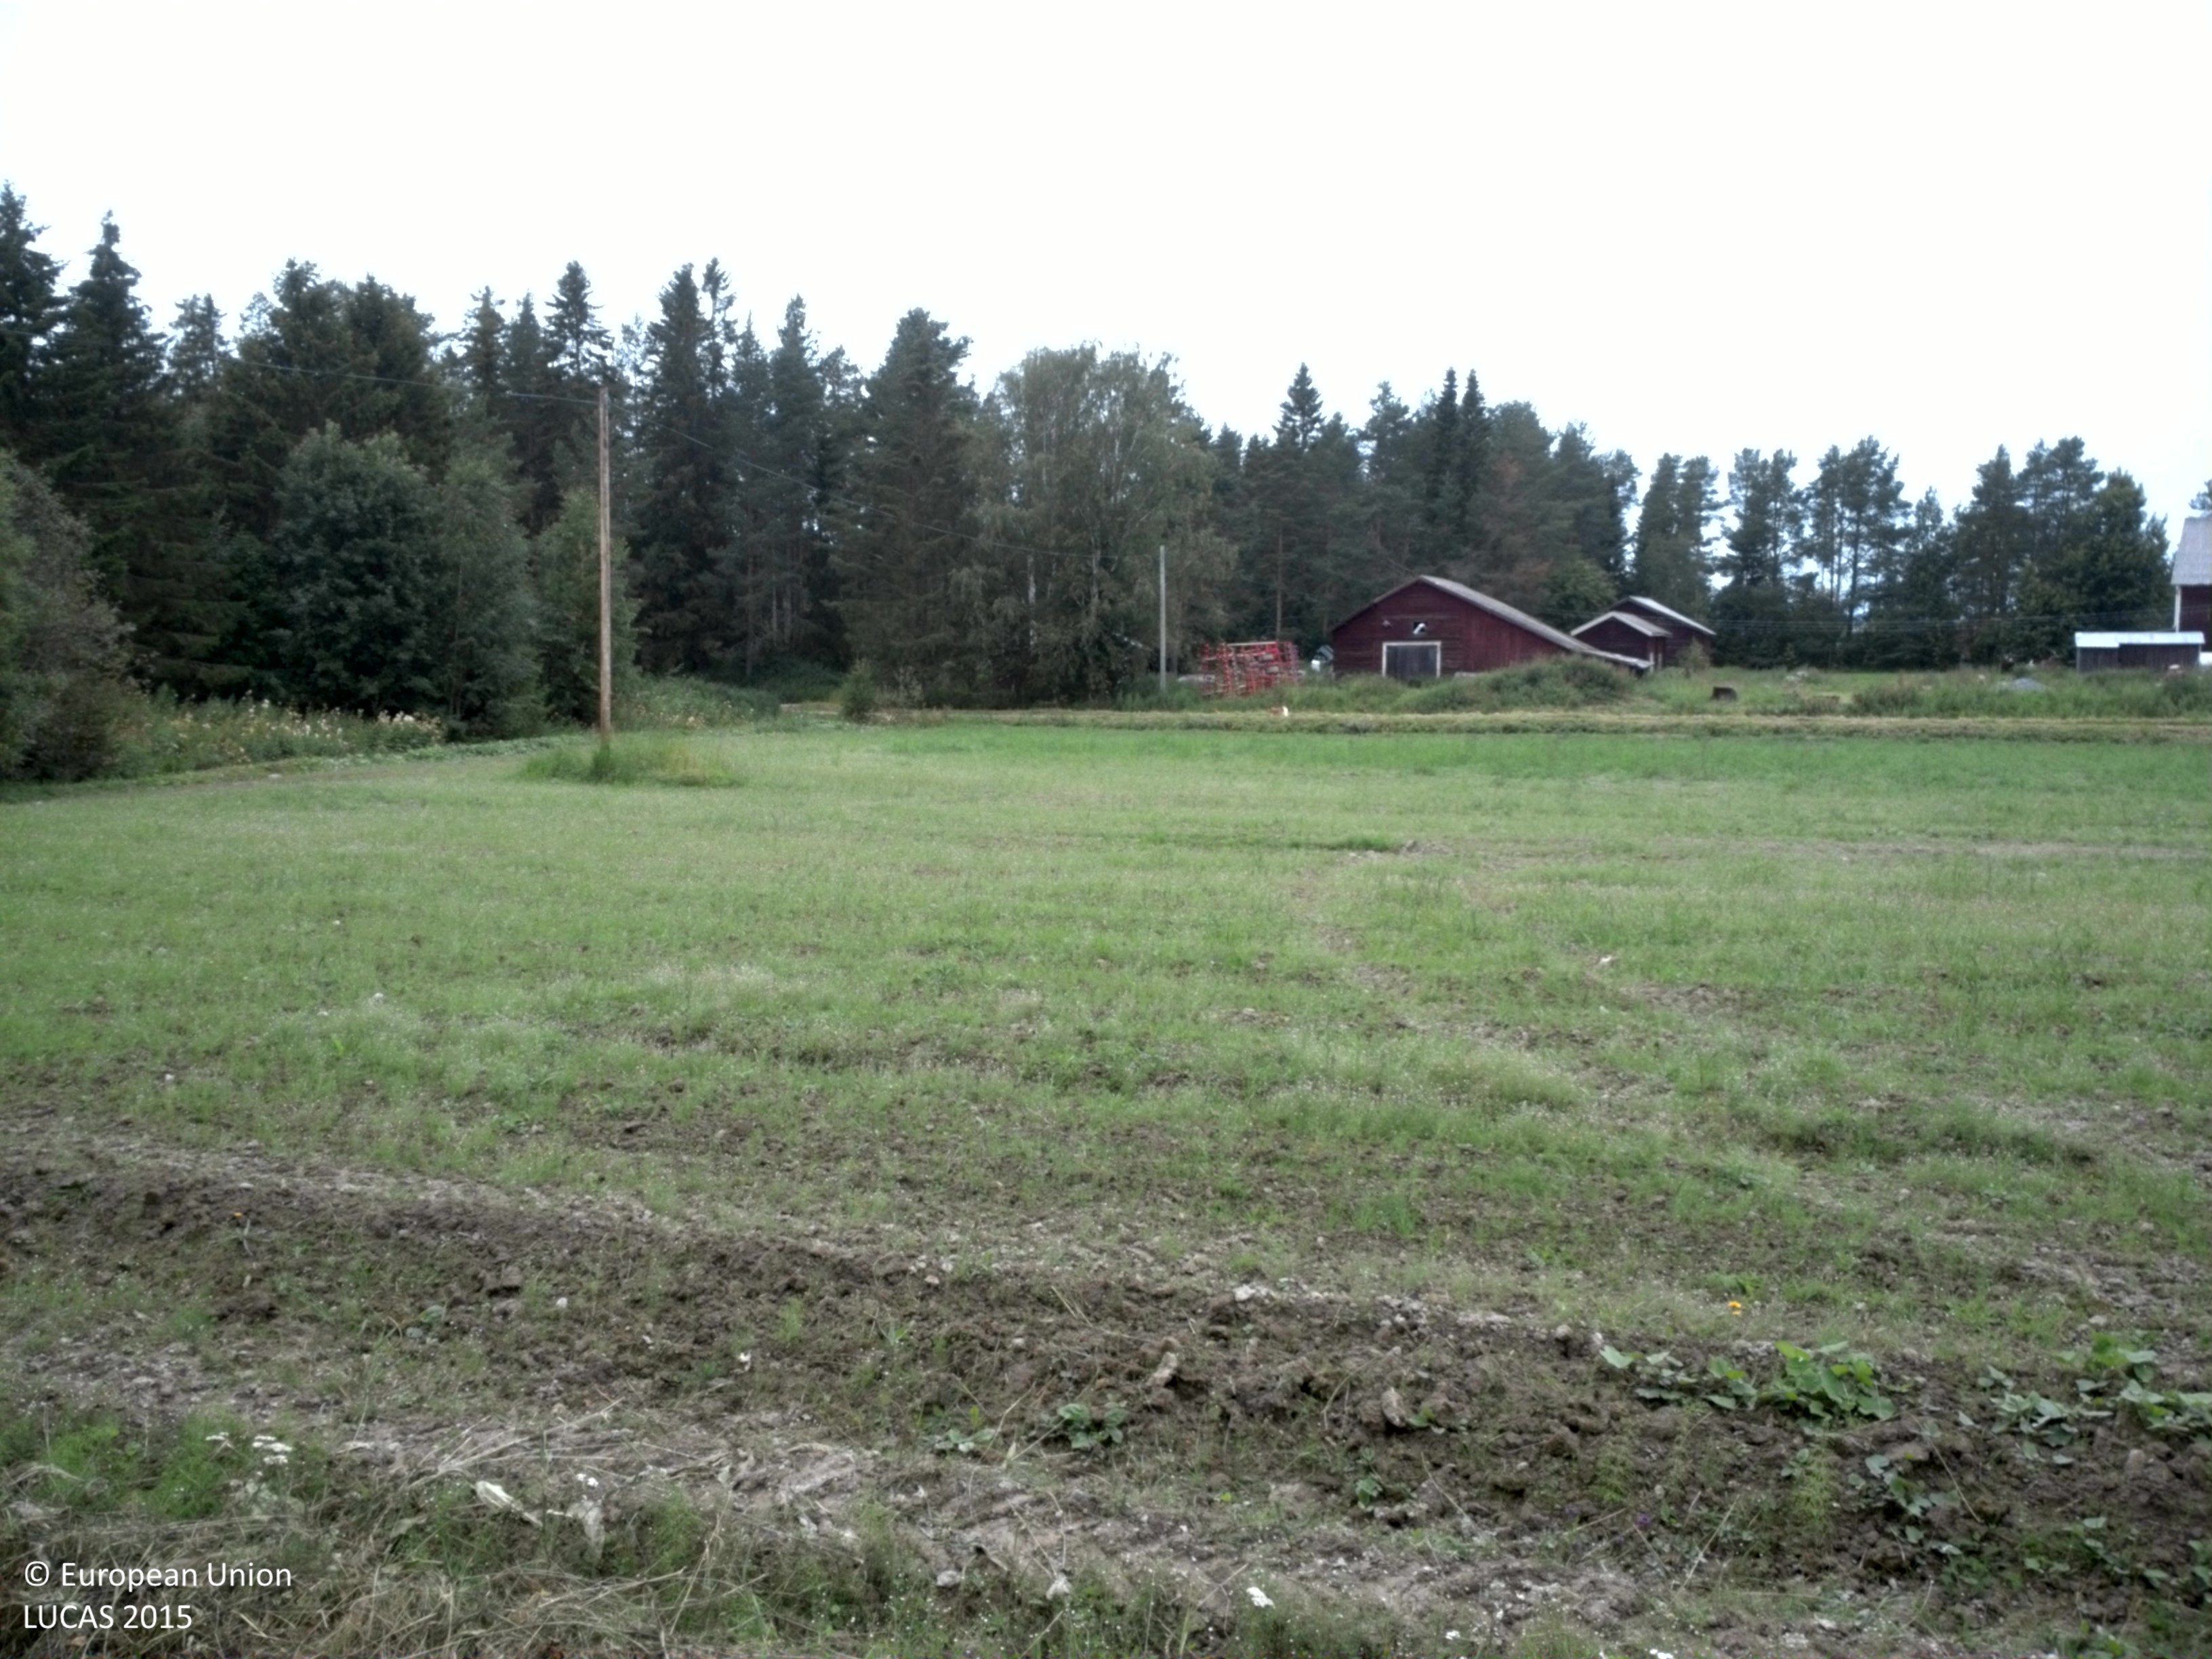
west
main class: Cropland
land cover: Temporary grasslands
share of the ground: > 75 %
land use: Agriculture (excluding fallow land and kitchen gardens)
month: August
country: SE
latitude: 64.5607
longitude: 20.7656
